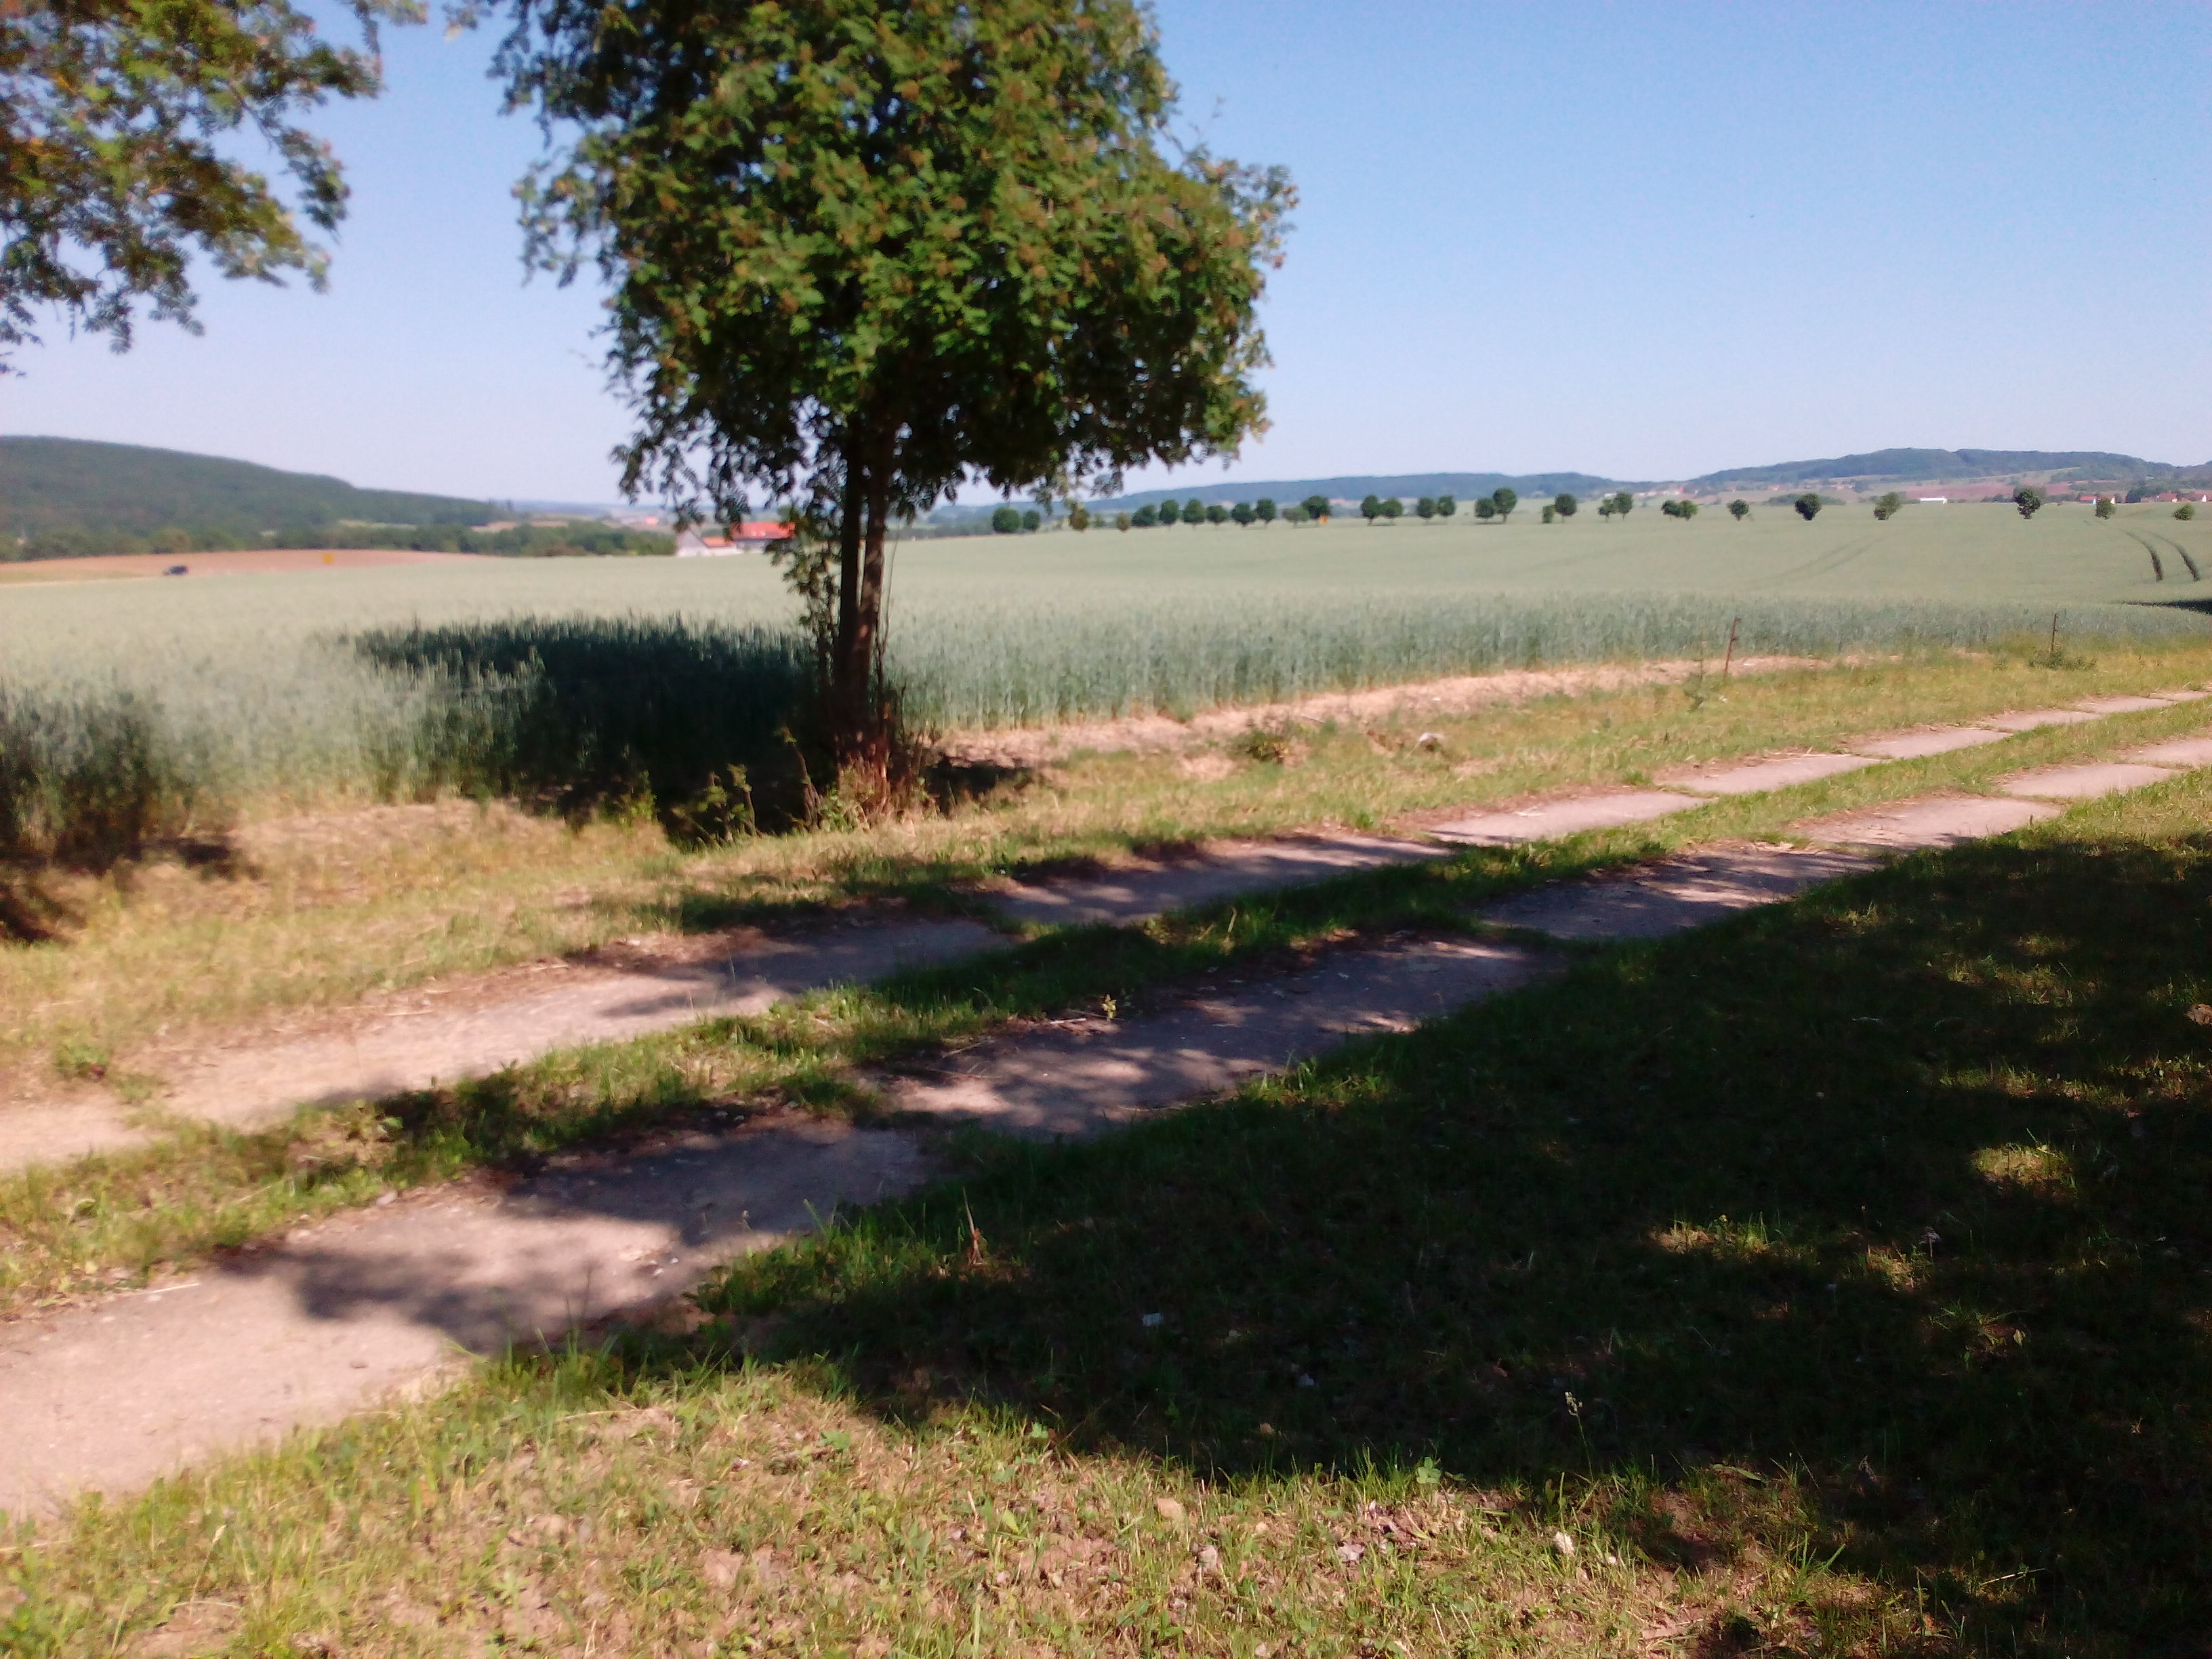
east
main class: Grassland
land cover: Grassland without tree/shrub cover
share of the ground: > 75 %
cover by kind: herbaceous plants 100 %
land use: Agriculture (excluding fallow land and kitchen gardens)
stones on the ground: < 10 %
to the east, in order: Grassland without tree/shrub cover; Paved roads, cycling and walking lanes; Grass margins; Lines of trees; Ditches and canals; Grass margins; Fences; Grass margins; Common wheat
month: June
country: DE
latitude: 50.3627
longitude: 10.5481
